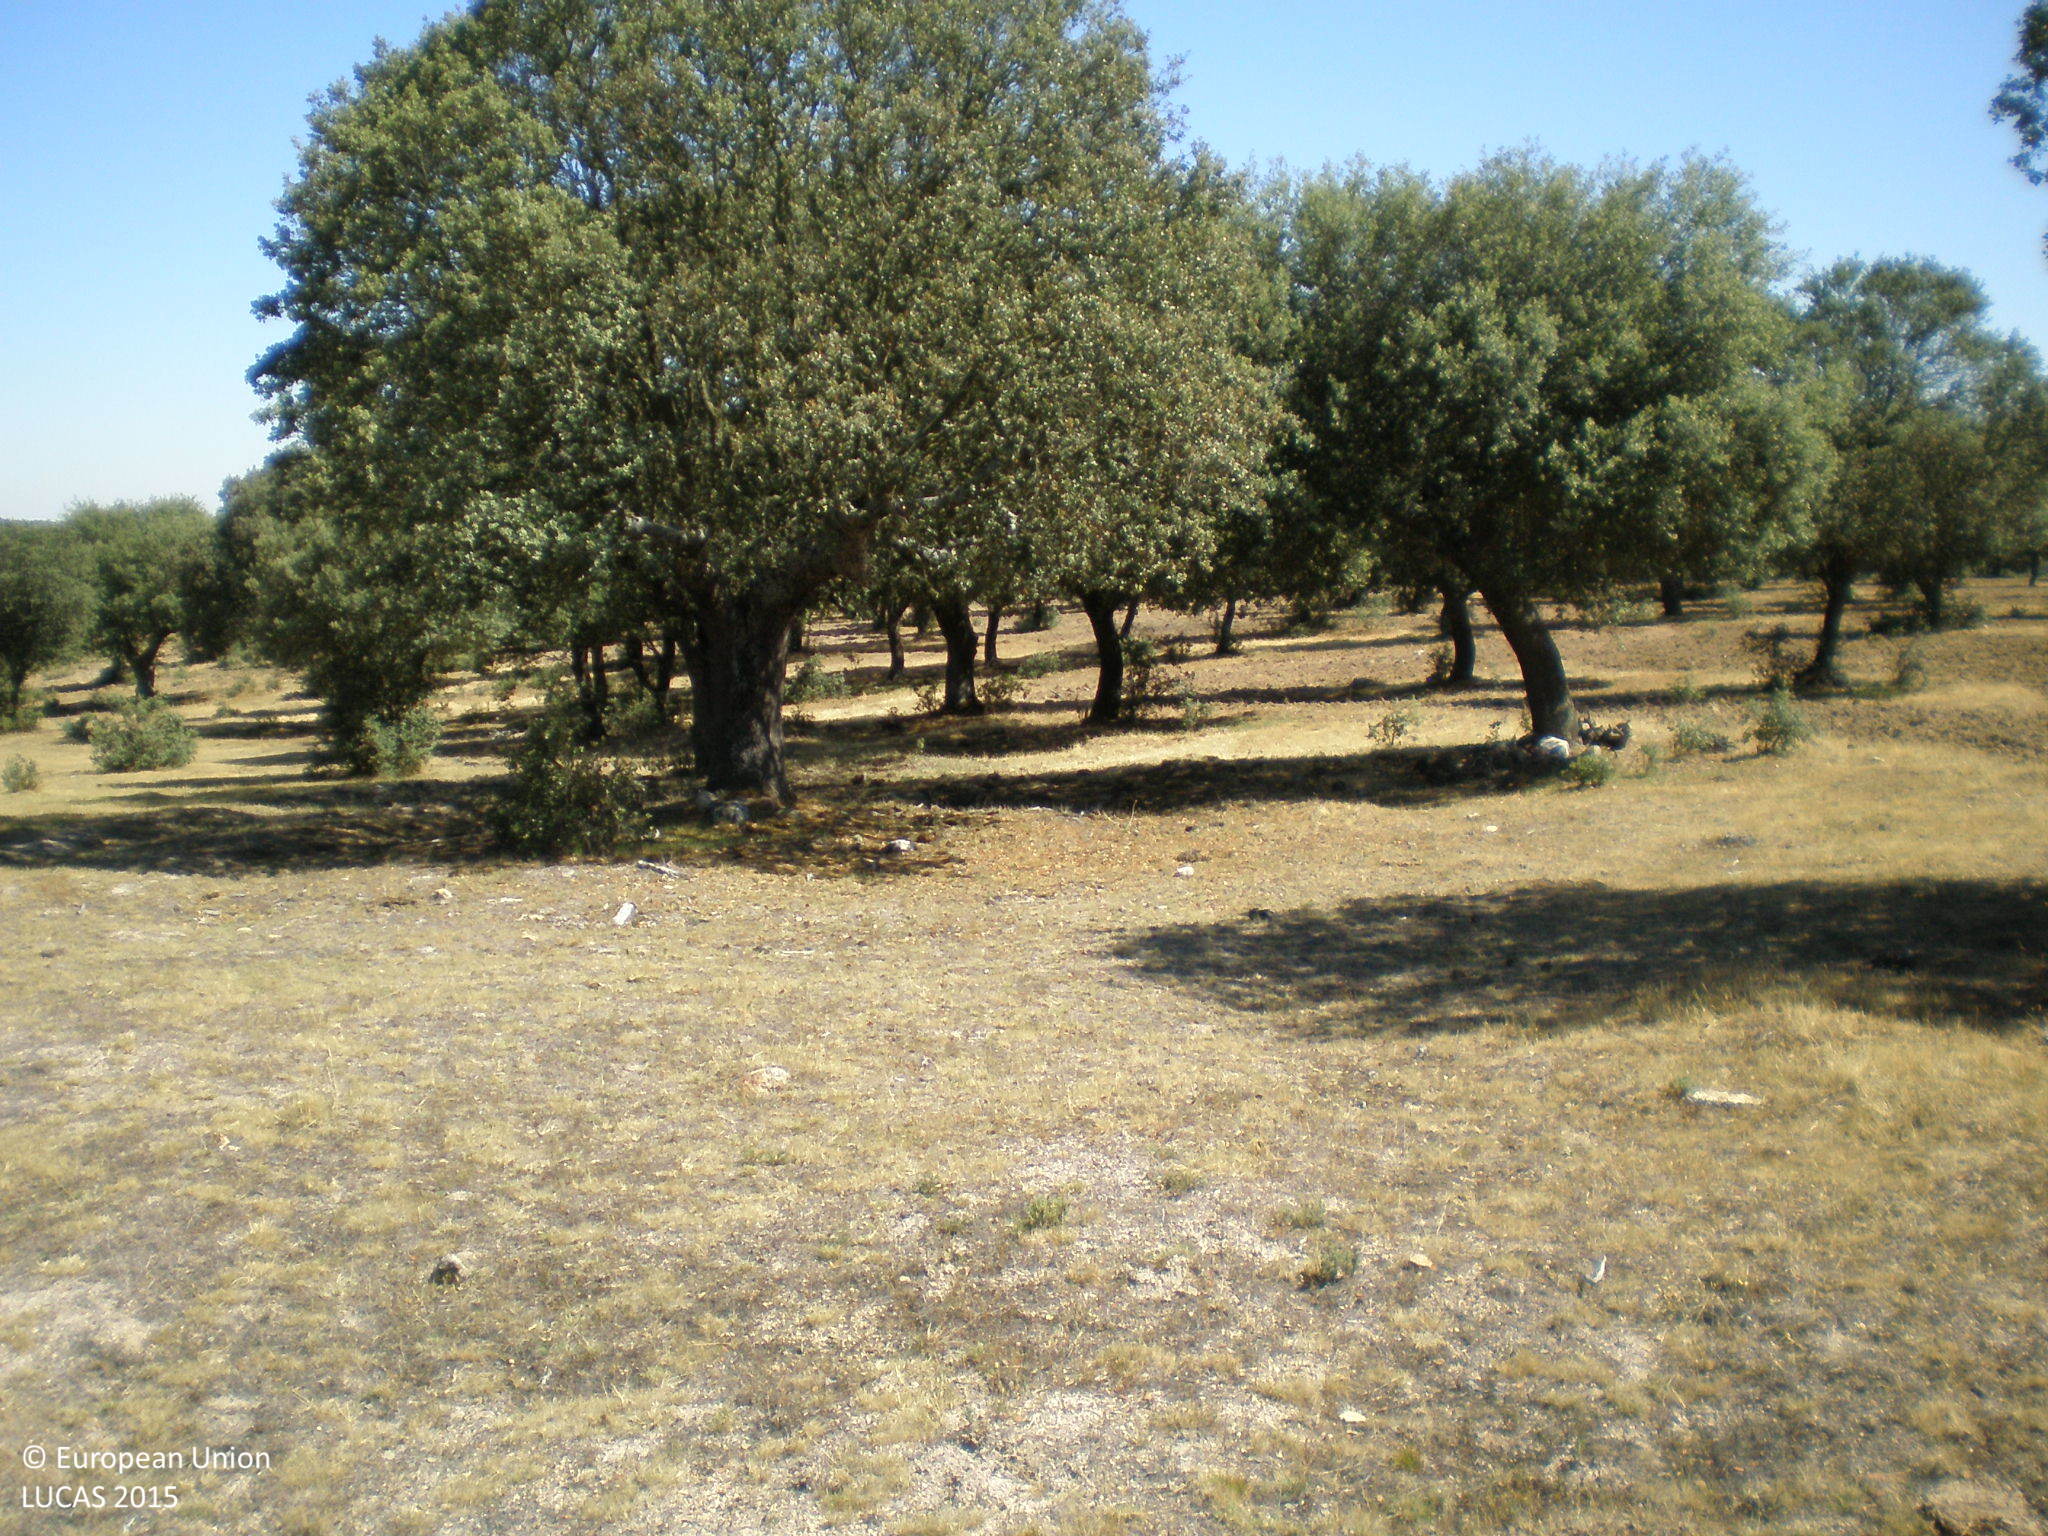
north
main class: Woodland
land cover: Broadleaved woodland
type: broadleaved evergreen forest
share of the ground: 25 - 50 %
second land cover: Grassland without tree/shrub cover
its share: 50 - 75 %
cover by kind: herbaceous plants 65 %, broadleaved forest trees 35 %
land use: Forestry
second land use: Agriculture (excluding fallow land and kitchen gardens)
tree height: > 5 m
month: June
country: ES
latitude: 40.8200
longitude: -5.6662
